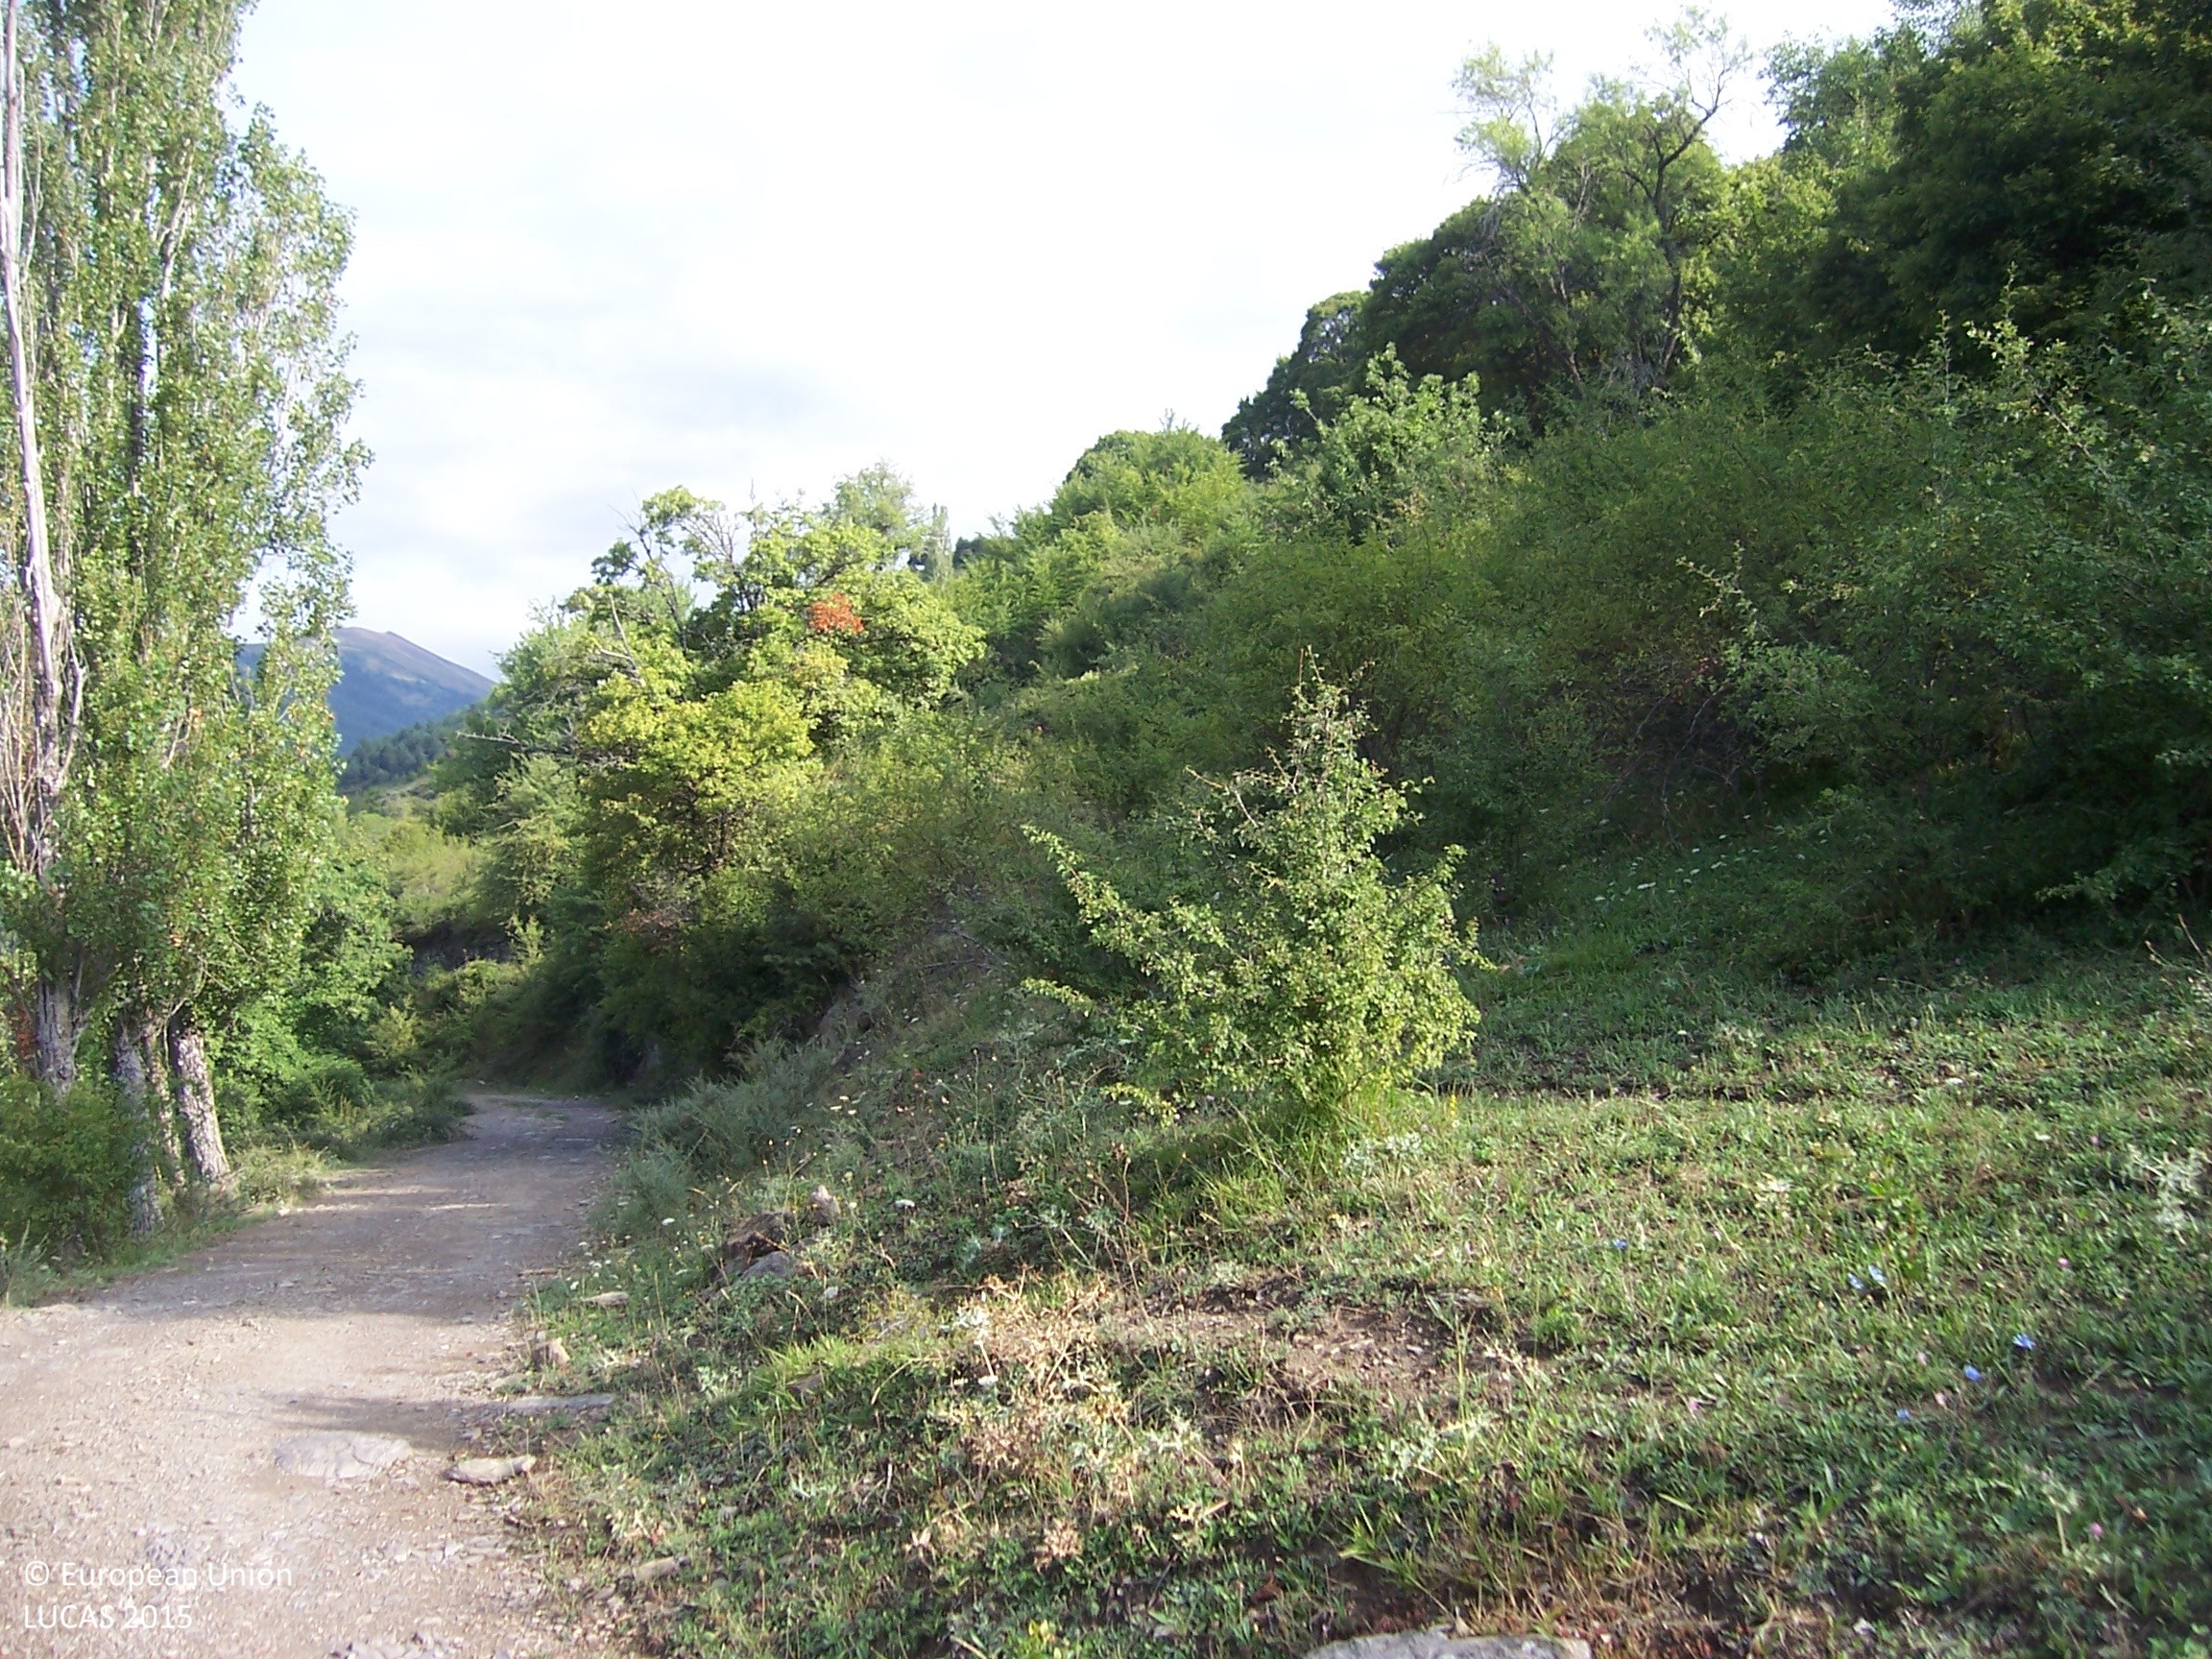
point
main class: Woodland
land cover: Broadleaved woodland
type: floodplain forest
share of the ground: > 75 %
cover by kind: broadleaved forest trees 50 %, herbaceous plants 20 %, consolidated bare surface 20 %, shrubs 10 %
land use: Semi-natural and natural areas not in use
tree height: > 5 m
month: August
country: ES
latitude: 42.6774
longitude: -0.4364
